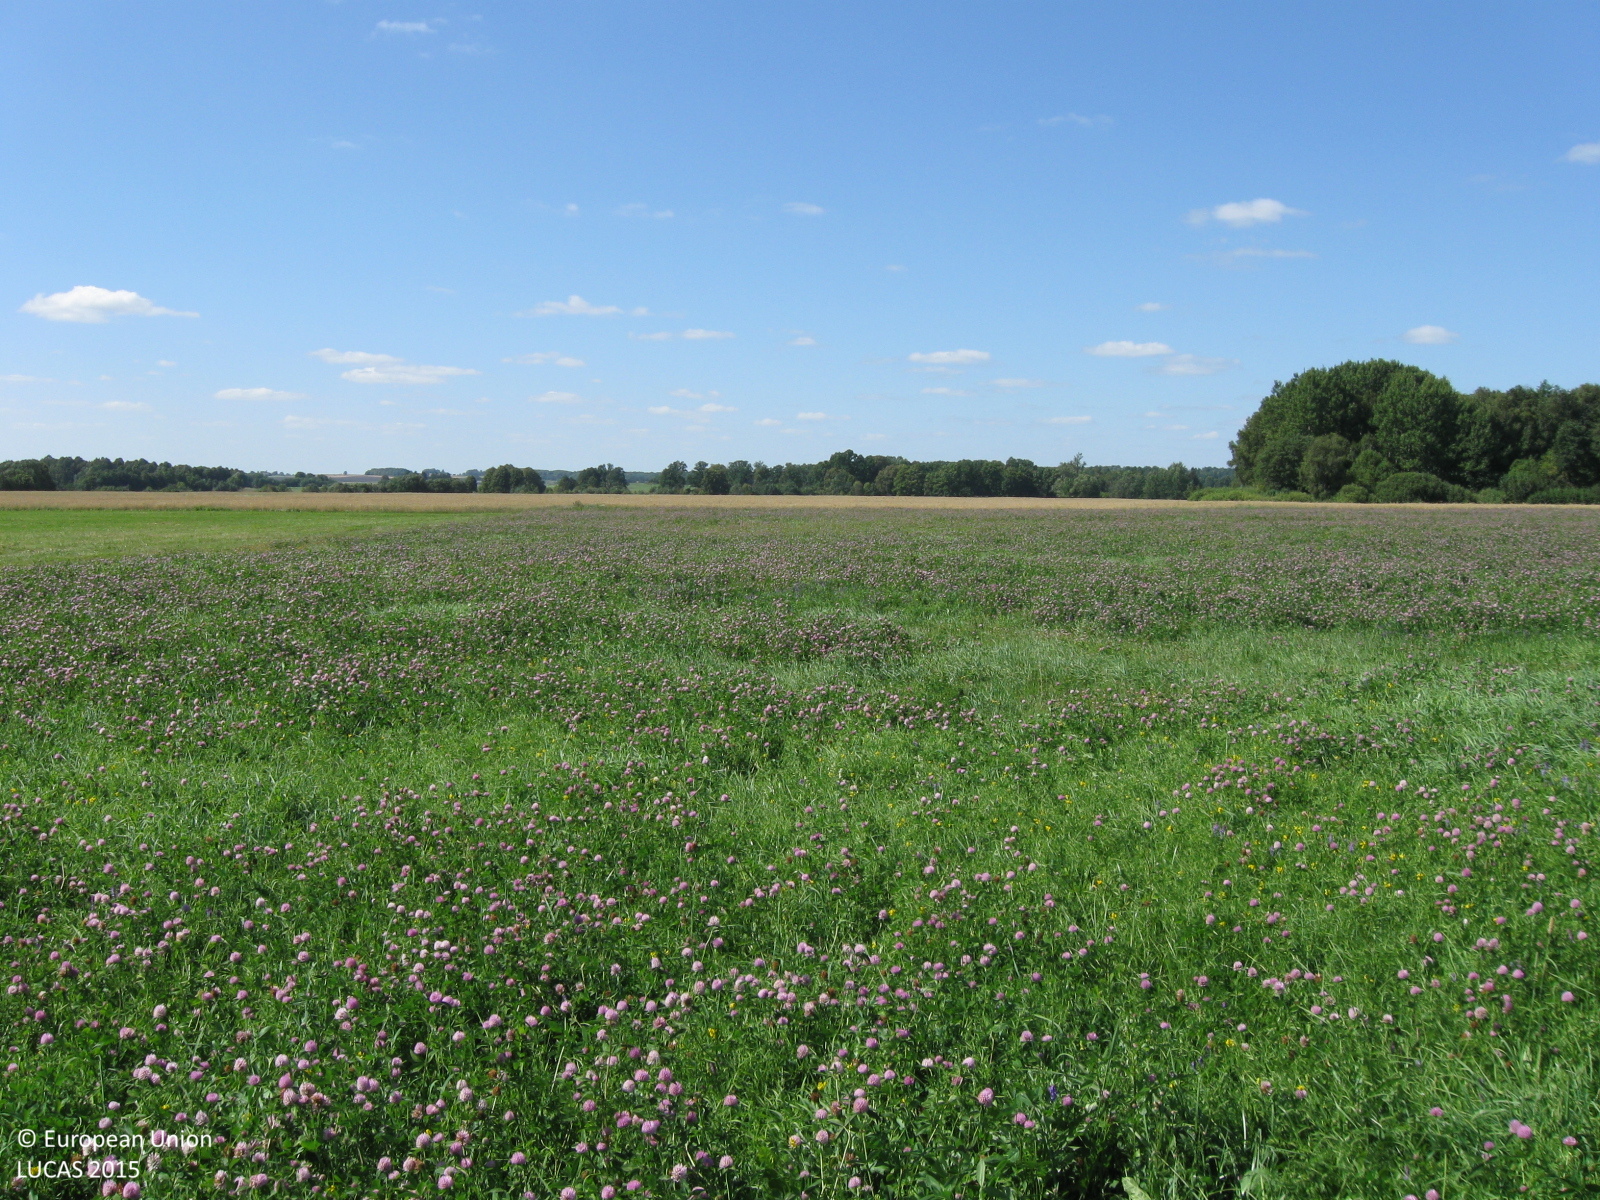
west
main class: Cropland
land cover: Other leguminous and mixtures for fodder
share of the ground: > 75 %
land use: Agriculture (excluding fallow land and kitchen gardens)
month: August
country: LT
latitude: 55.5454
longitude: 22.5990
